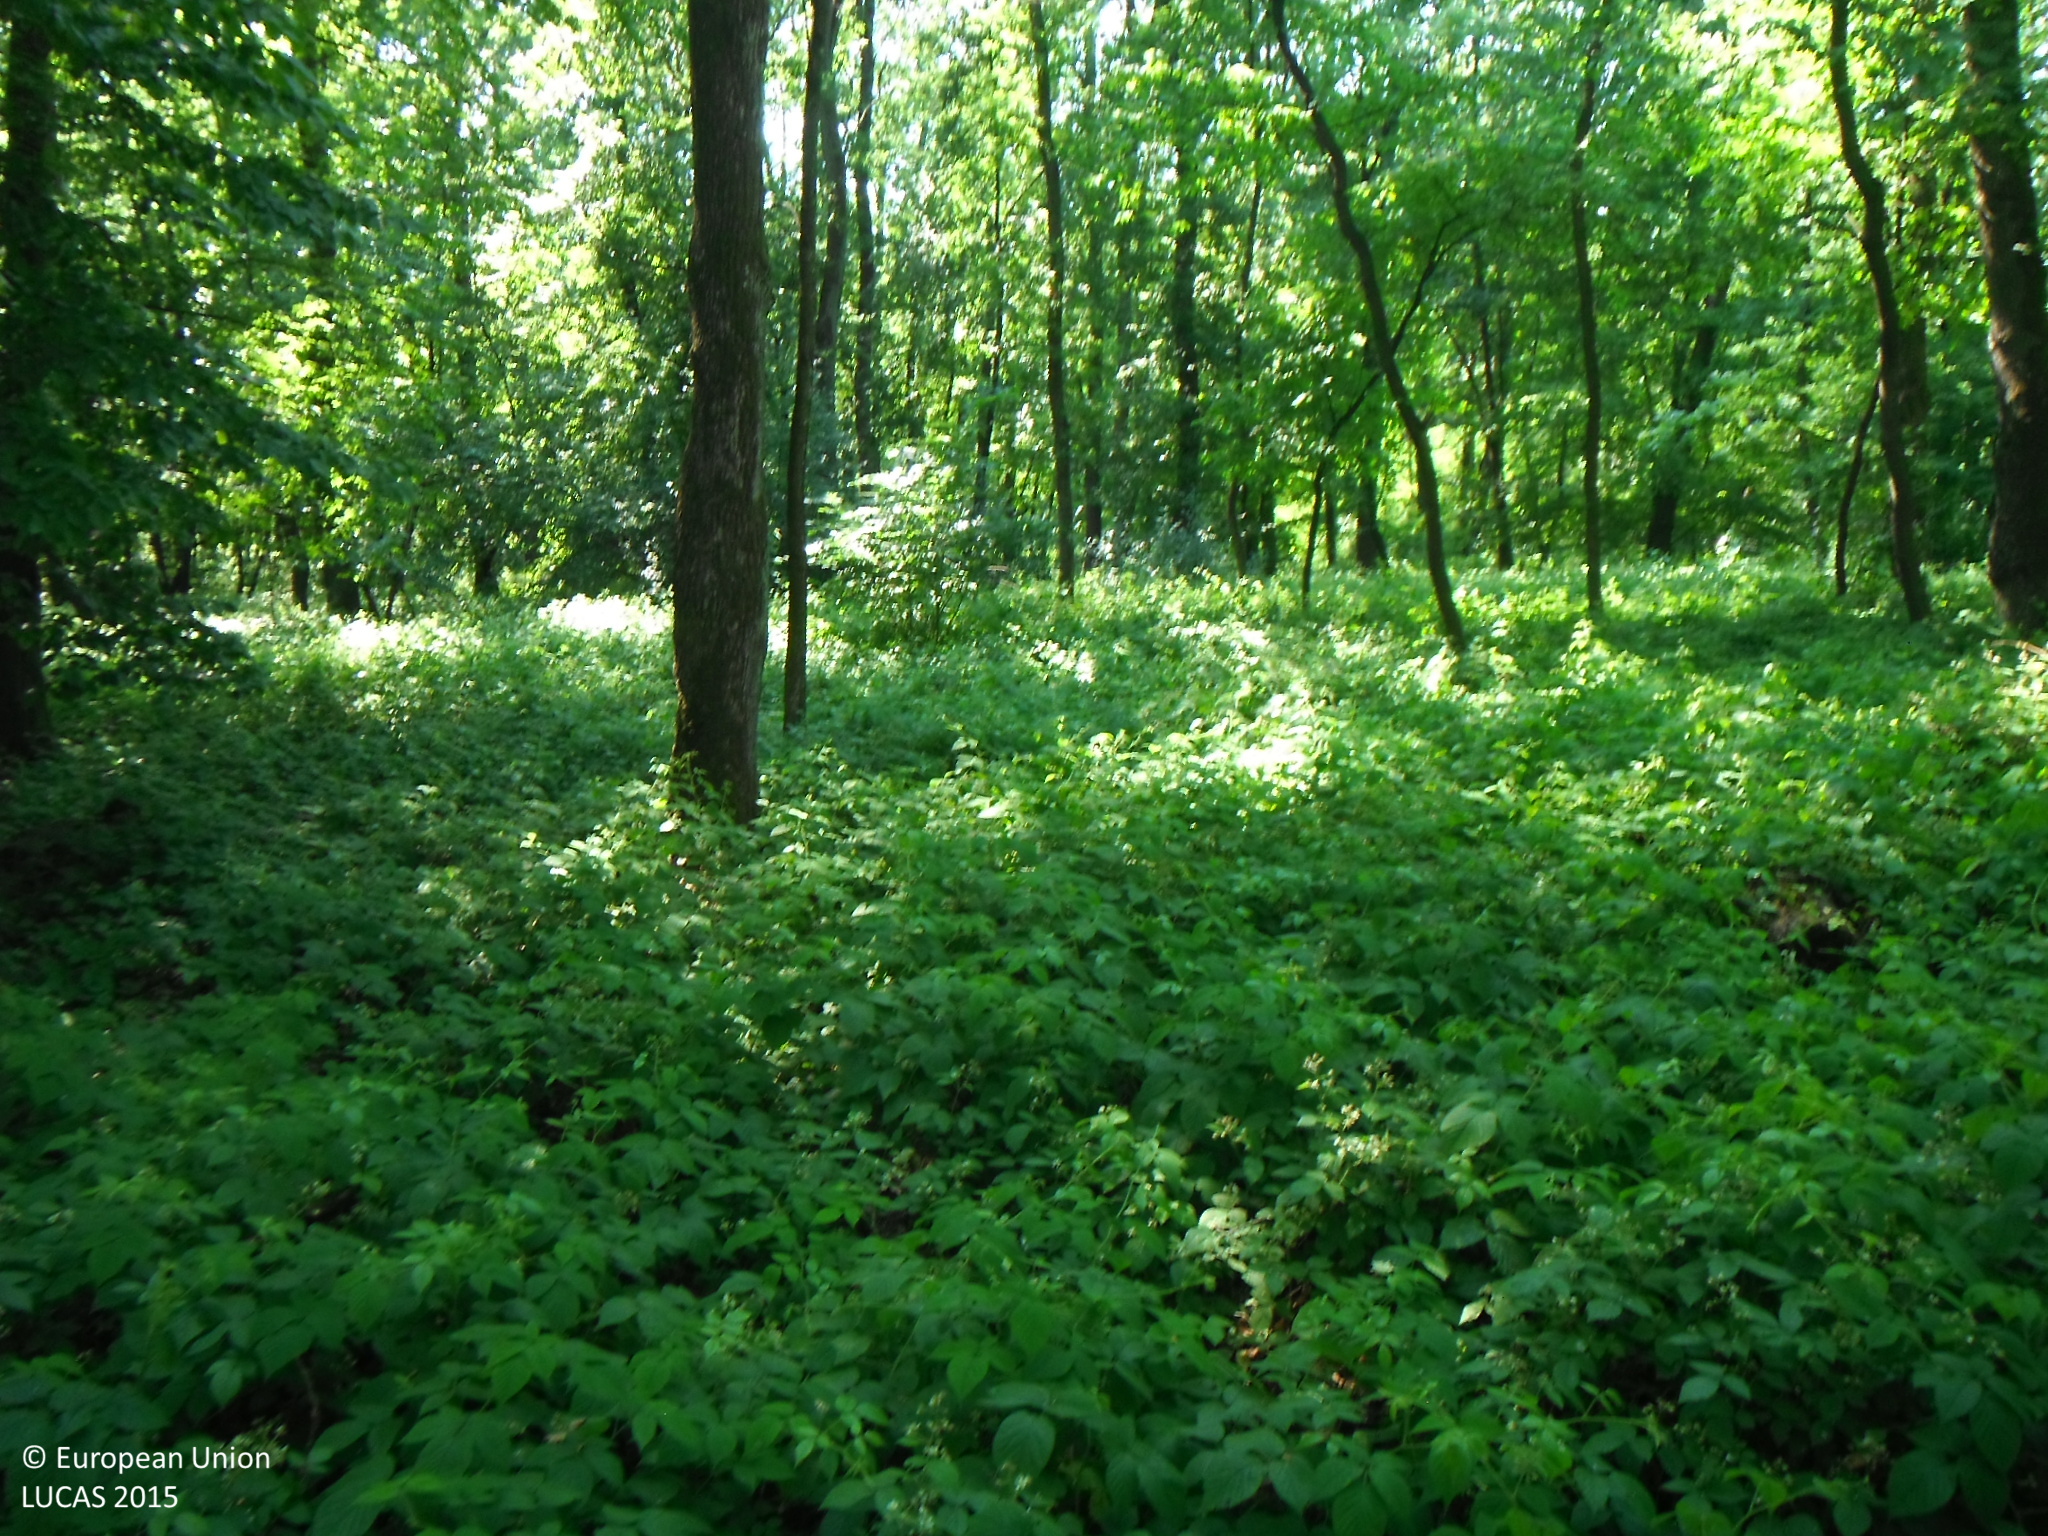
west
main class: Woodland
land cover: Broadleaved woodland
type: beech forest
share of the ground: > 75 %
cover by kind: broadleaved forest trees 80 %, herbaceous plants 20 %
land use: Forestry
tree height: > 5 m
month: June
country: SK
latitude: 48.7730
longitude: 21.9328
